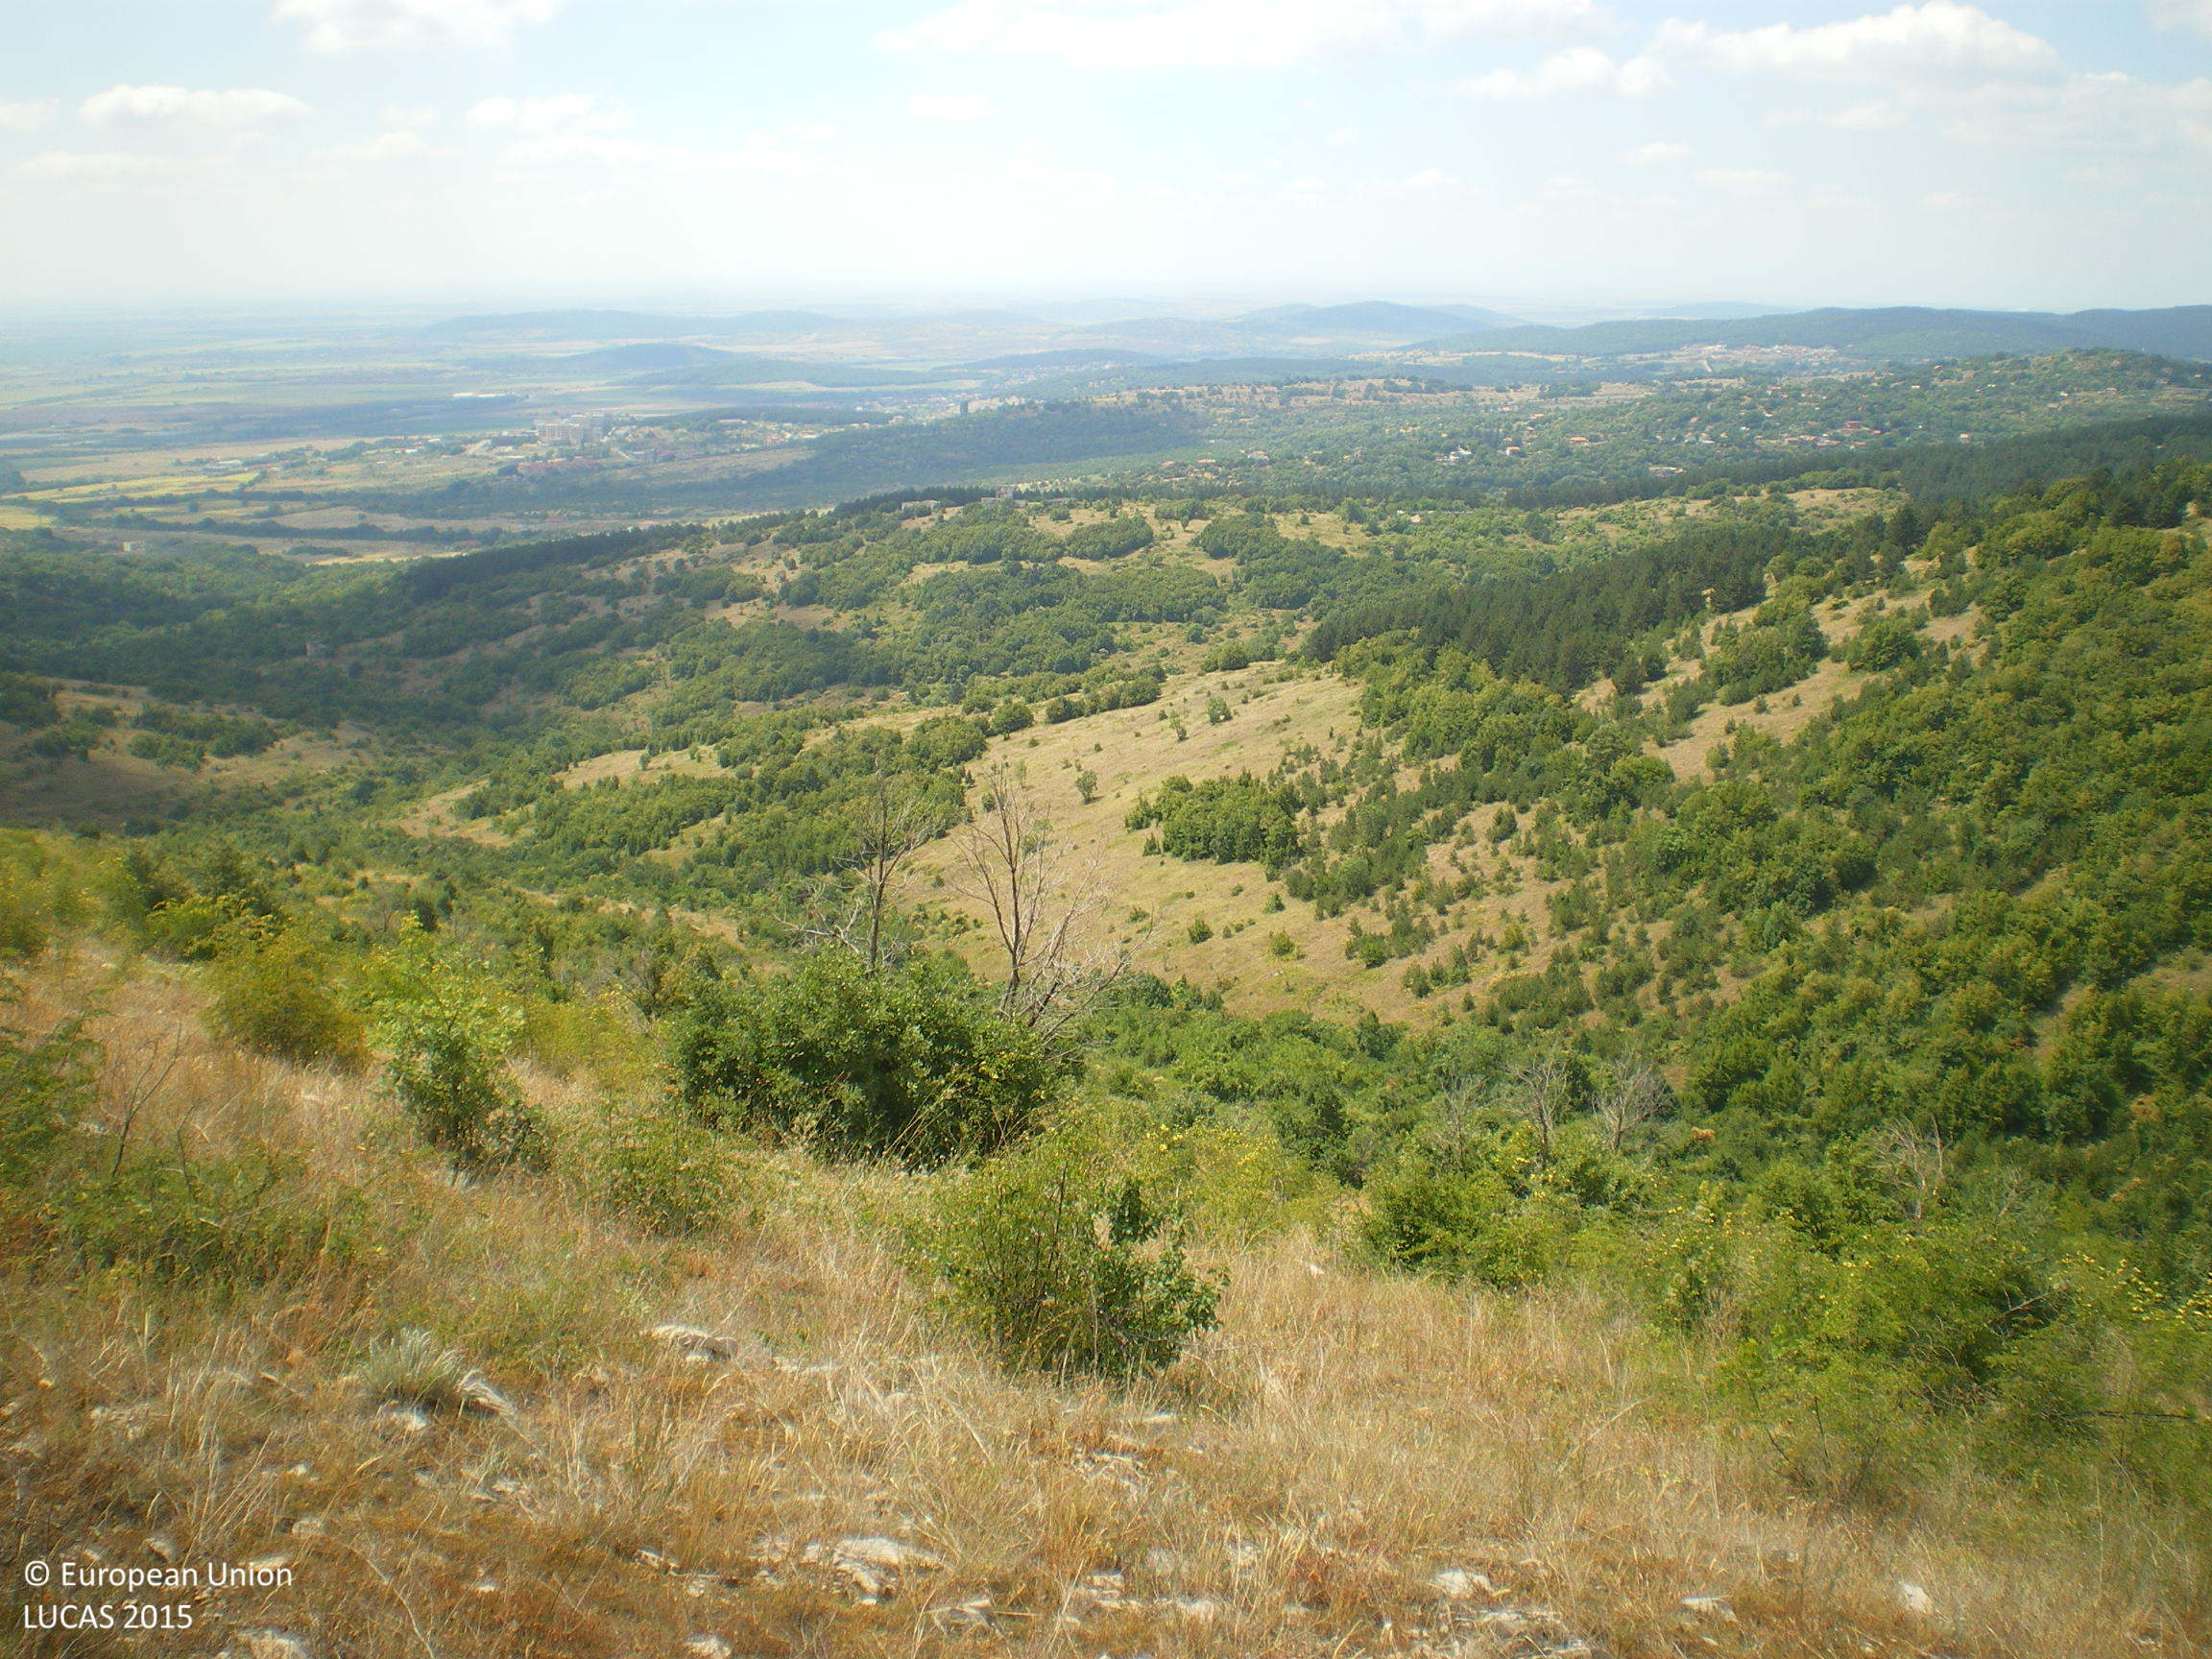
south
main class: Shrubland
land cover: Shrubland without tree cover
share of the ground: 10 - 25 %
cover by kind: herbaceous plants 90 %, shrubs 10 %
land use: Semi-natural and natural areas not in use
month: August
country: BG
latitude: 42.4328
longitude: 25.5690
